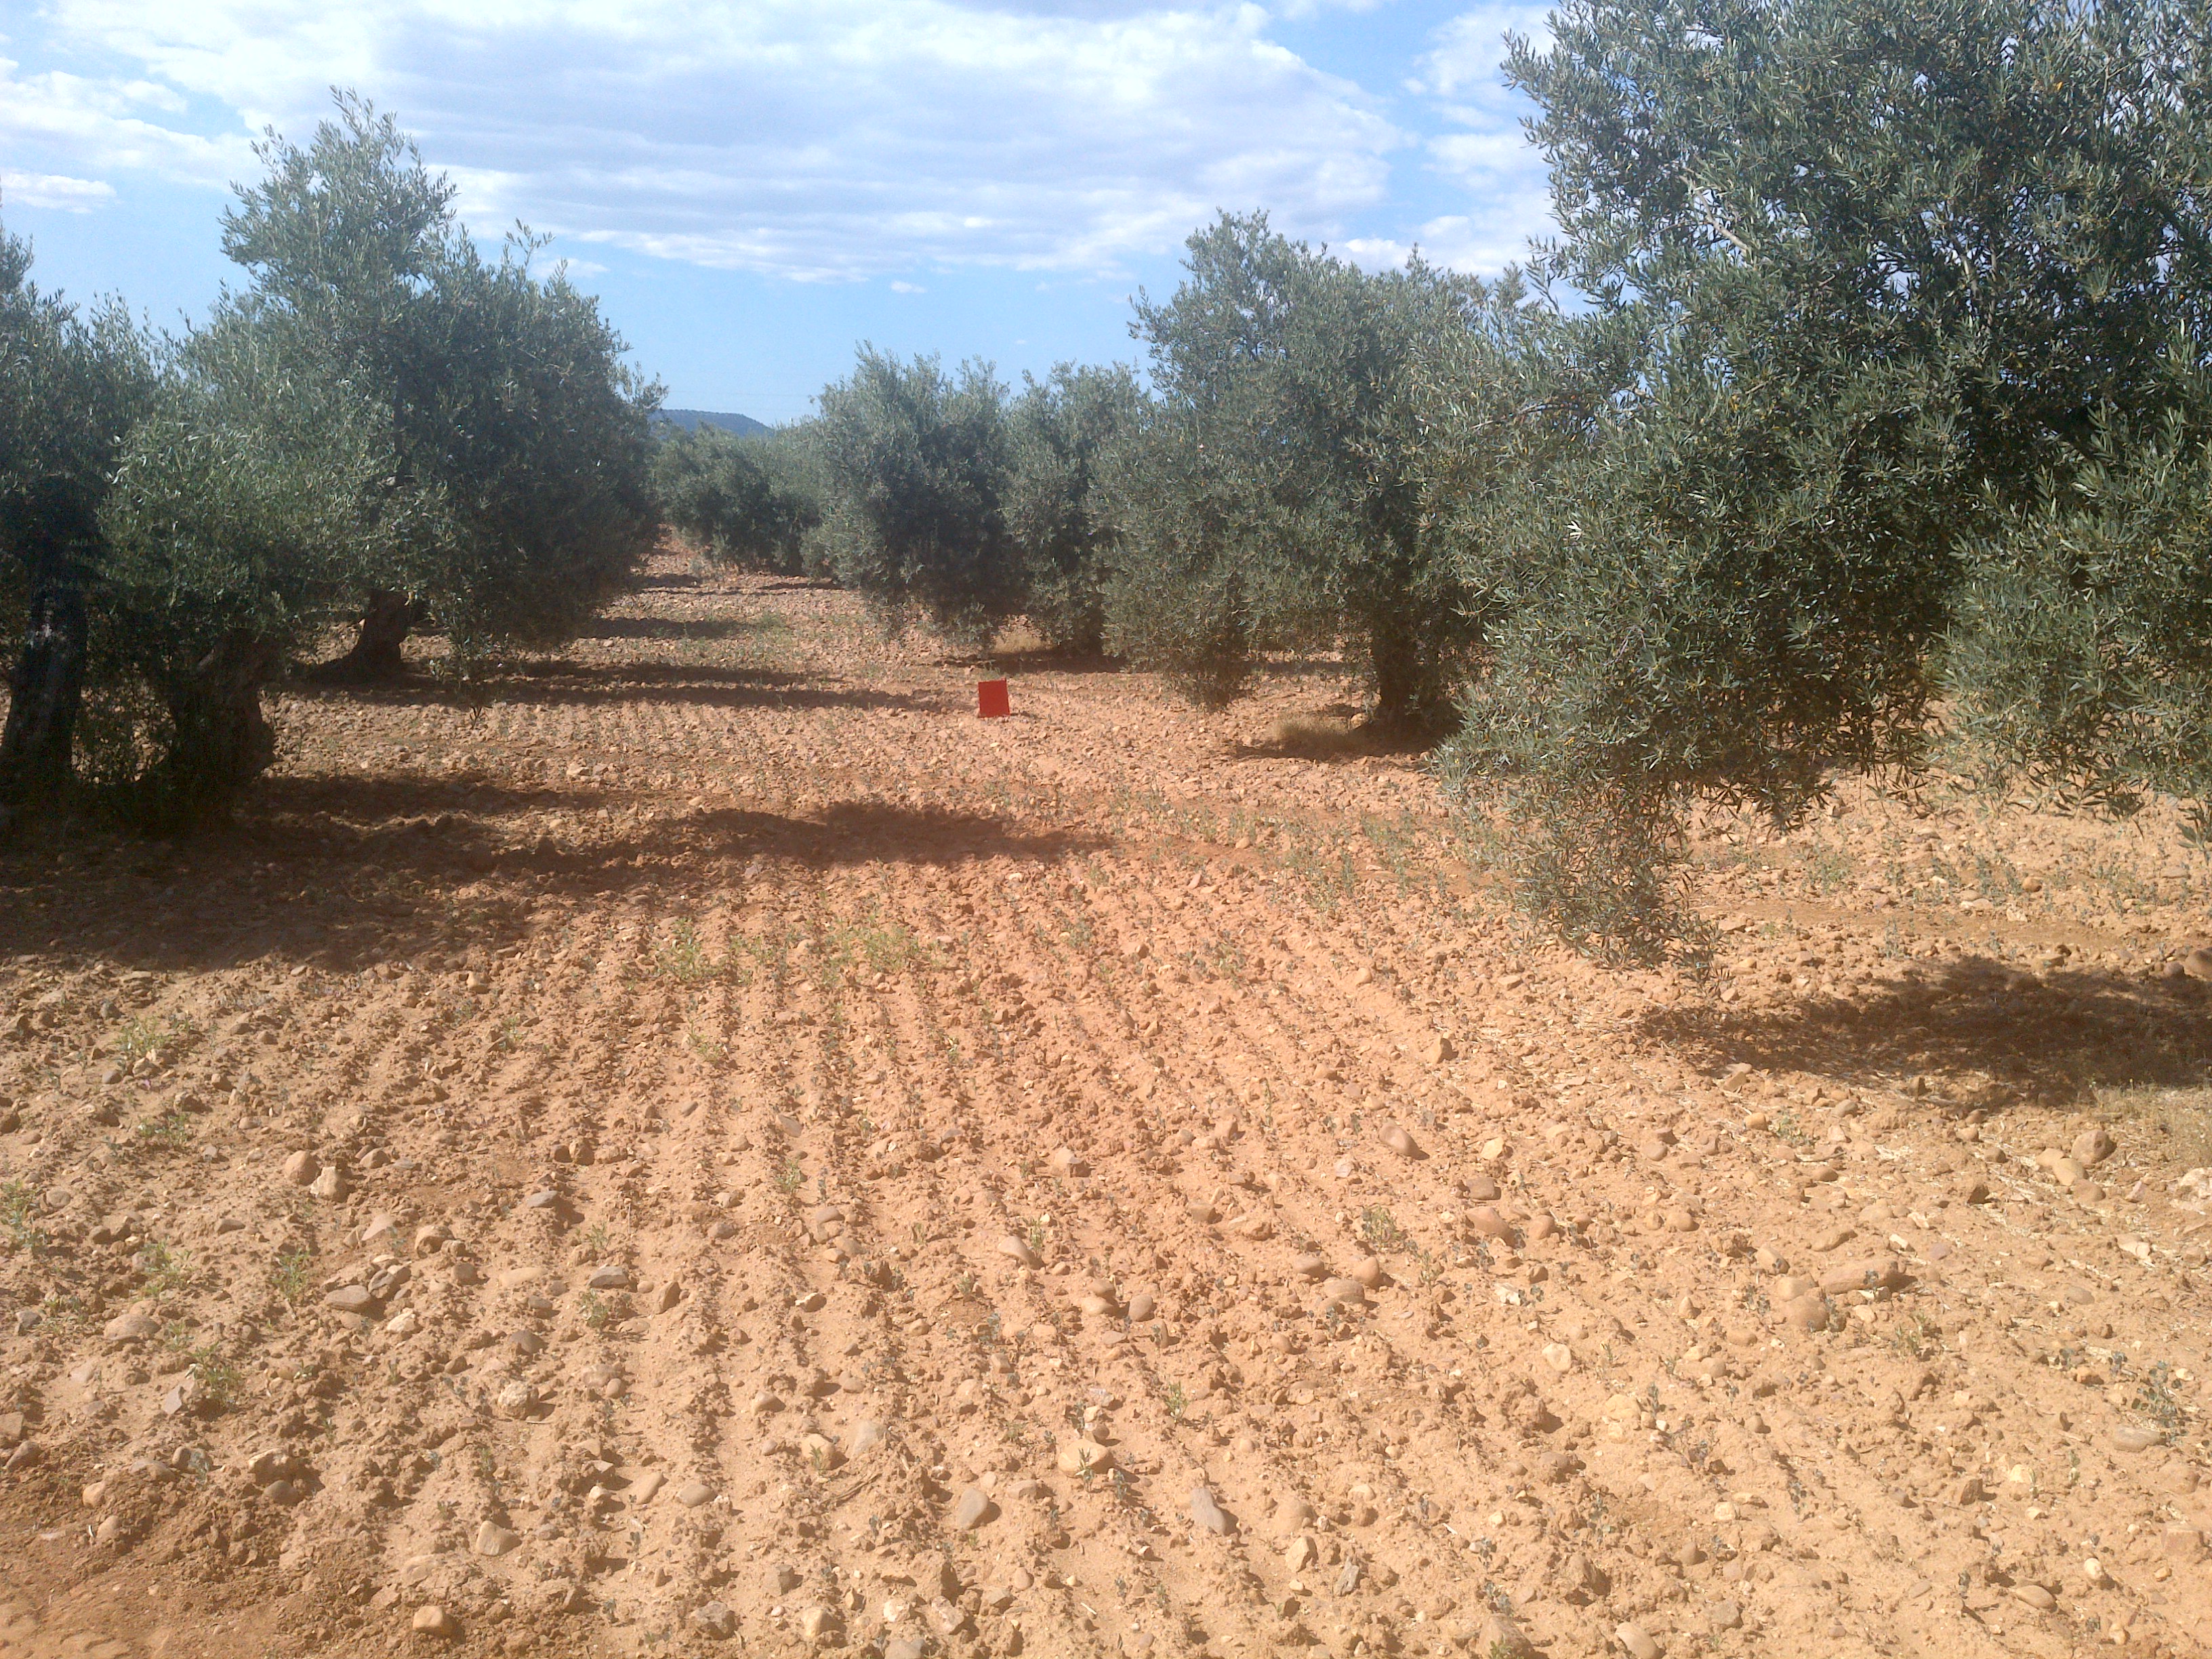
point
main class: Cropland
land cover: Olive groves
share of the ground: 50 - 75 %
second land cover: Other bare soil
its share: > 75 %
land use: Agriculture (excluding fallow land and kitchen gardens)
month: May
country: ES
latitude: 37.9082
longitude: -4.6742
